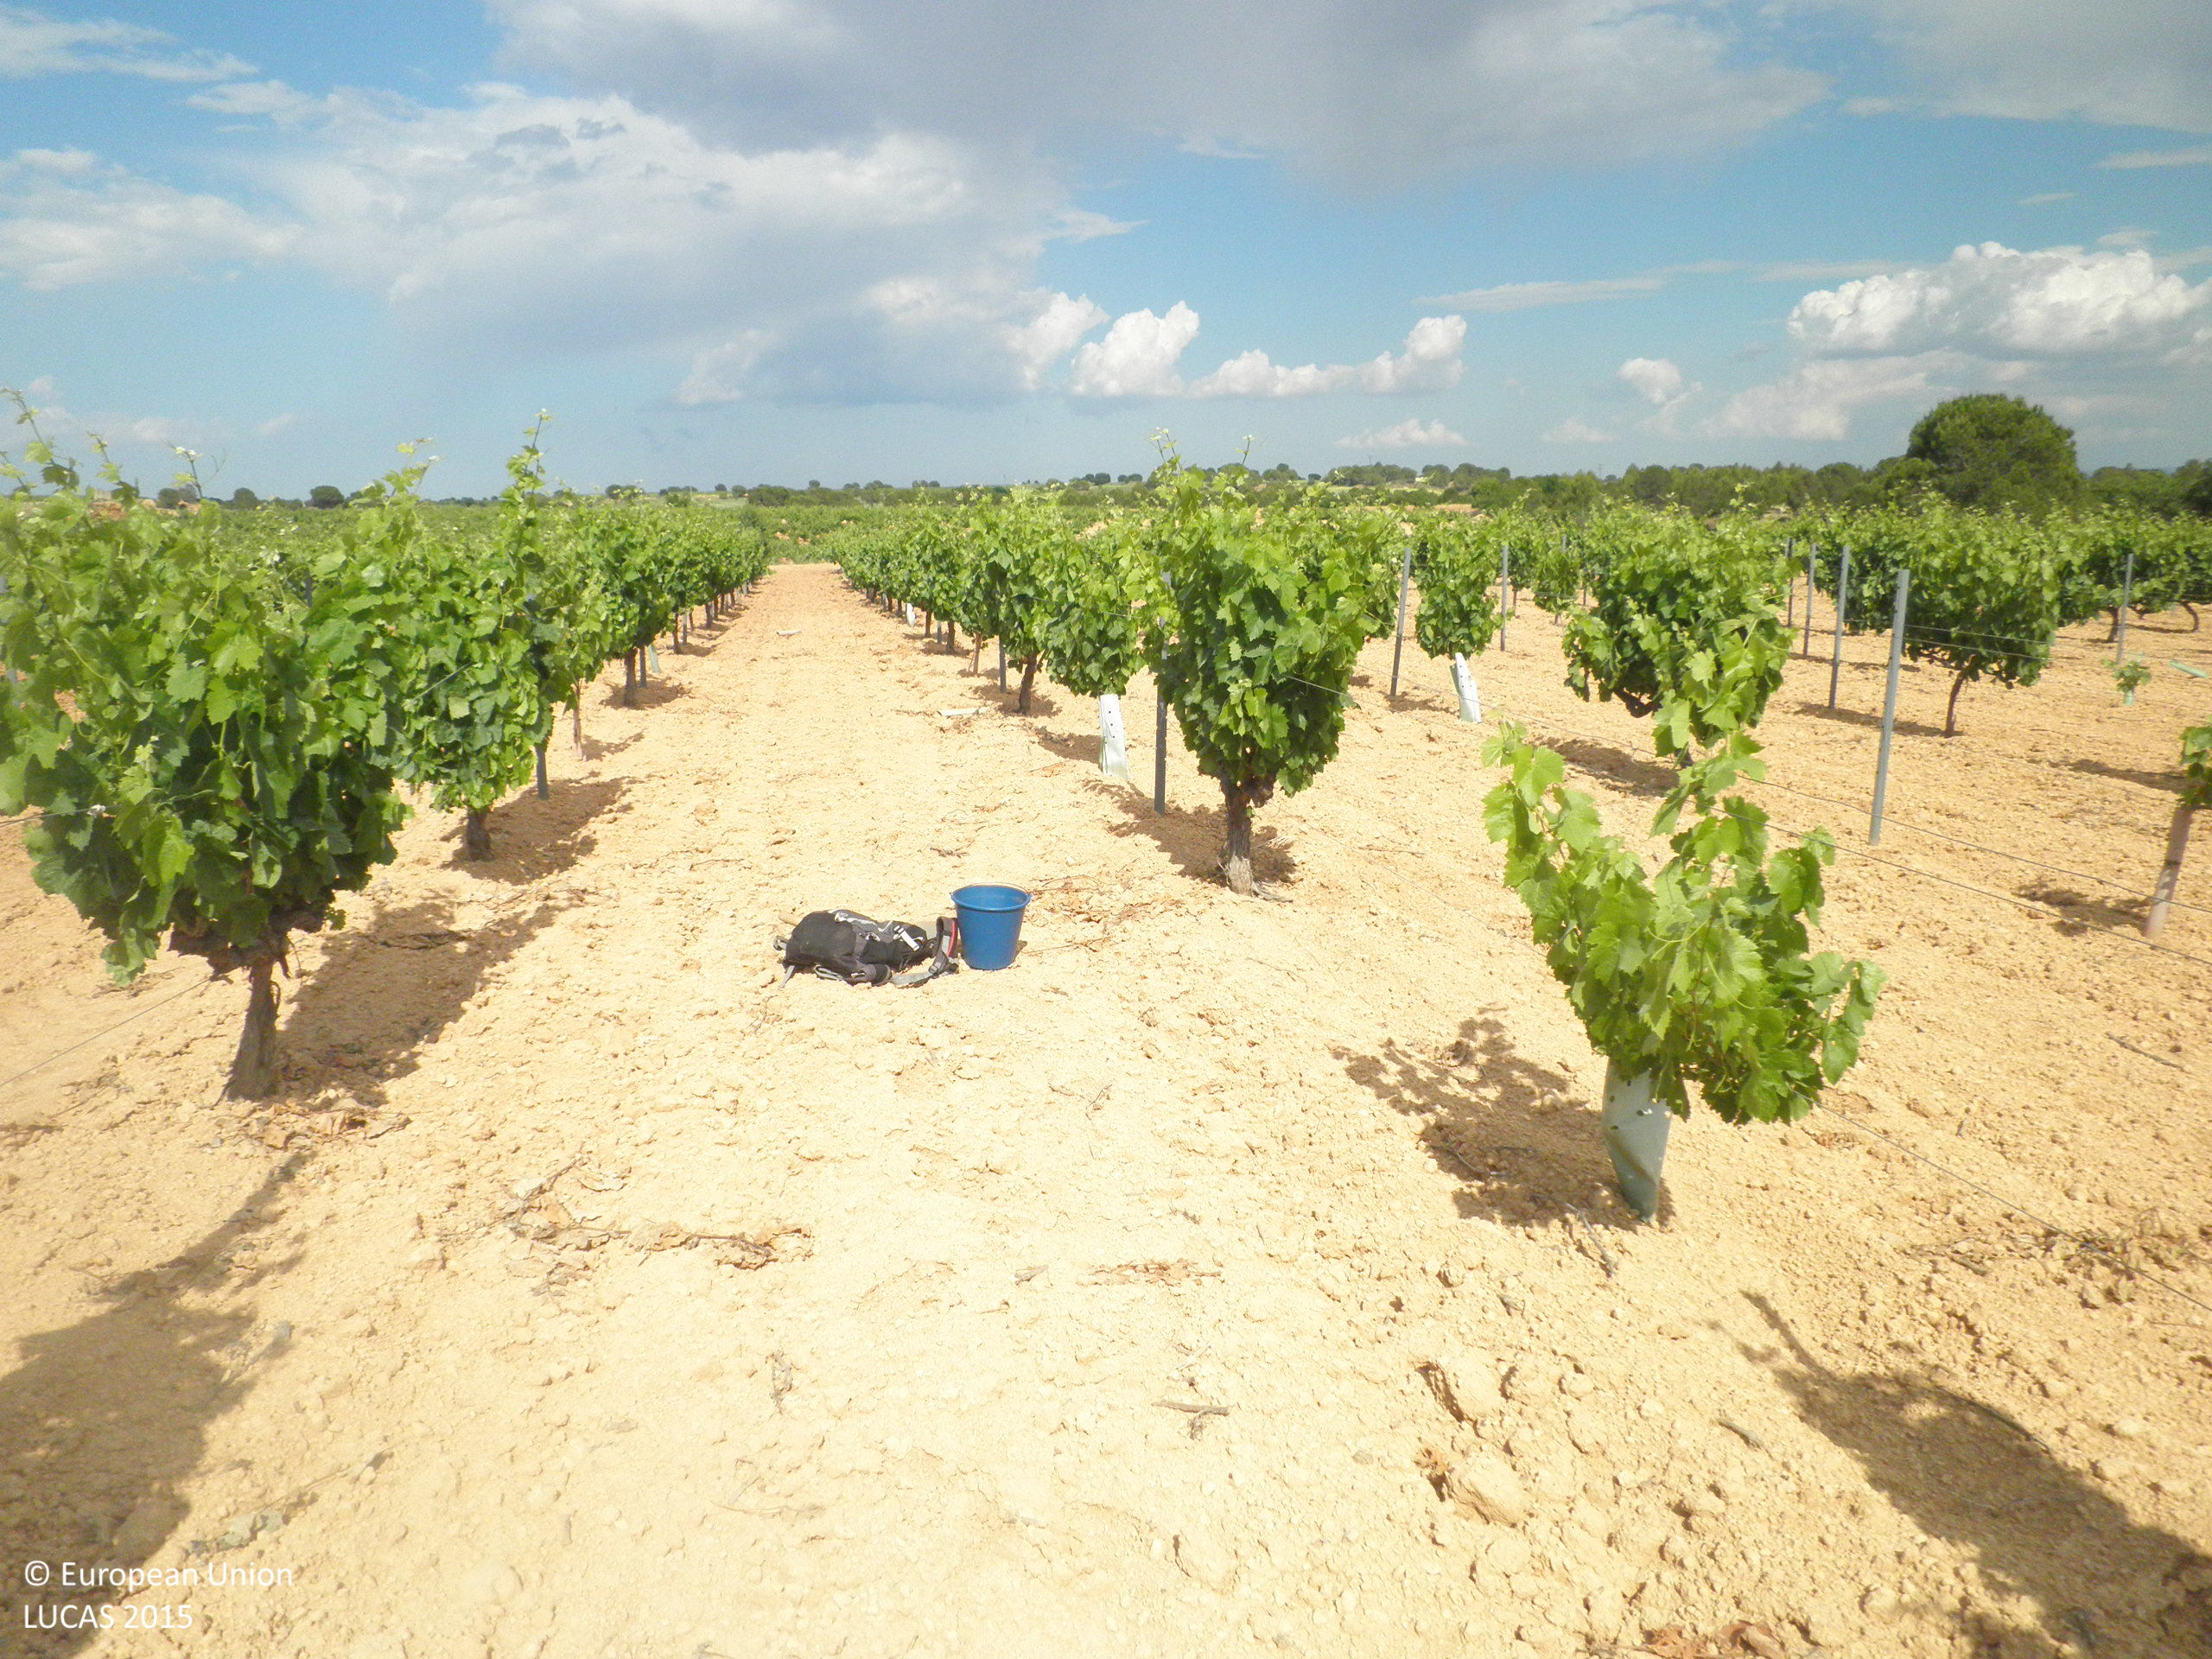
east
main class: Cropland
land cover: Vineyards
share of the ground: < 10 %
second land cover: Other bare soil
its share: > 75 %
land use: Agriculture (excluding fallow land and kitchen gardens)
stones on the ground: < 10 %
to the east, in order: Vineyards; Other bare soil; Grass margins; Dry stone walls; Grass margins; Vineyards; Grass margins; Tracks; Grass margins; Other bare soil
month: June
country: ES
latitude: 39.3139
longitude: -1.6590
